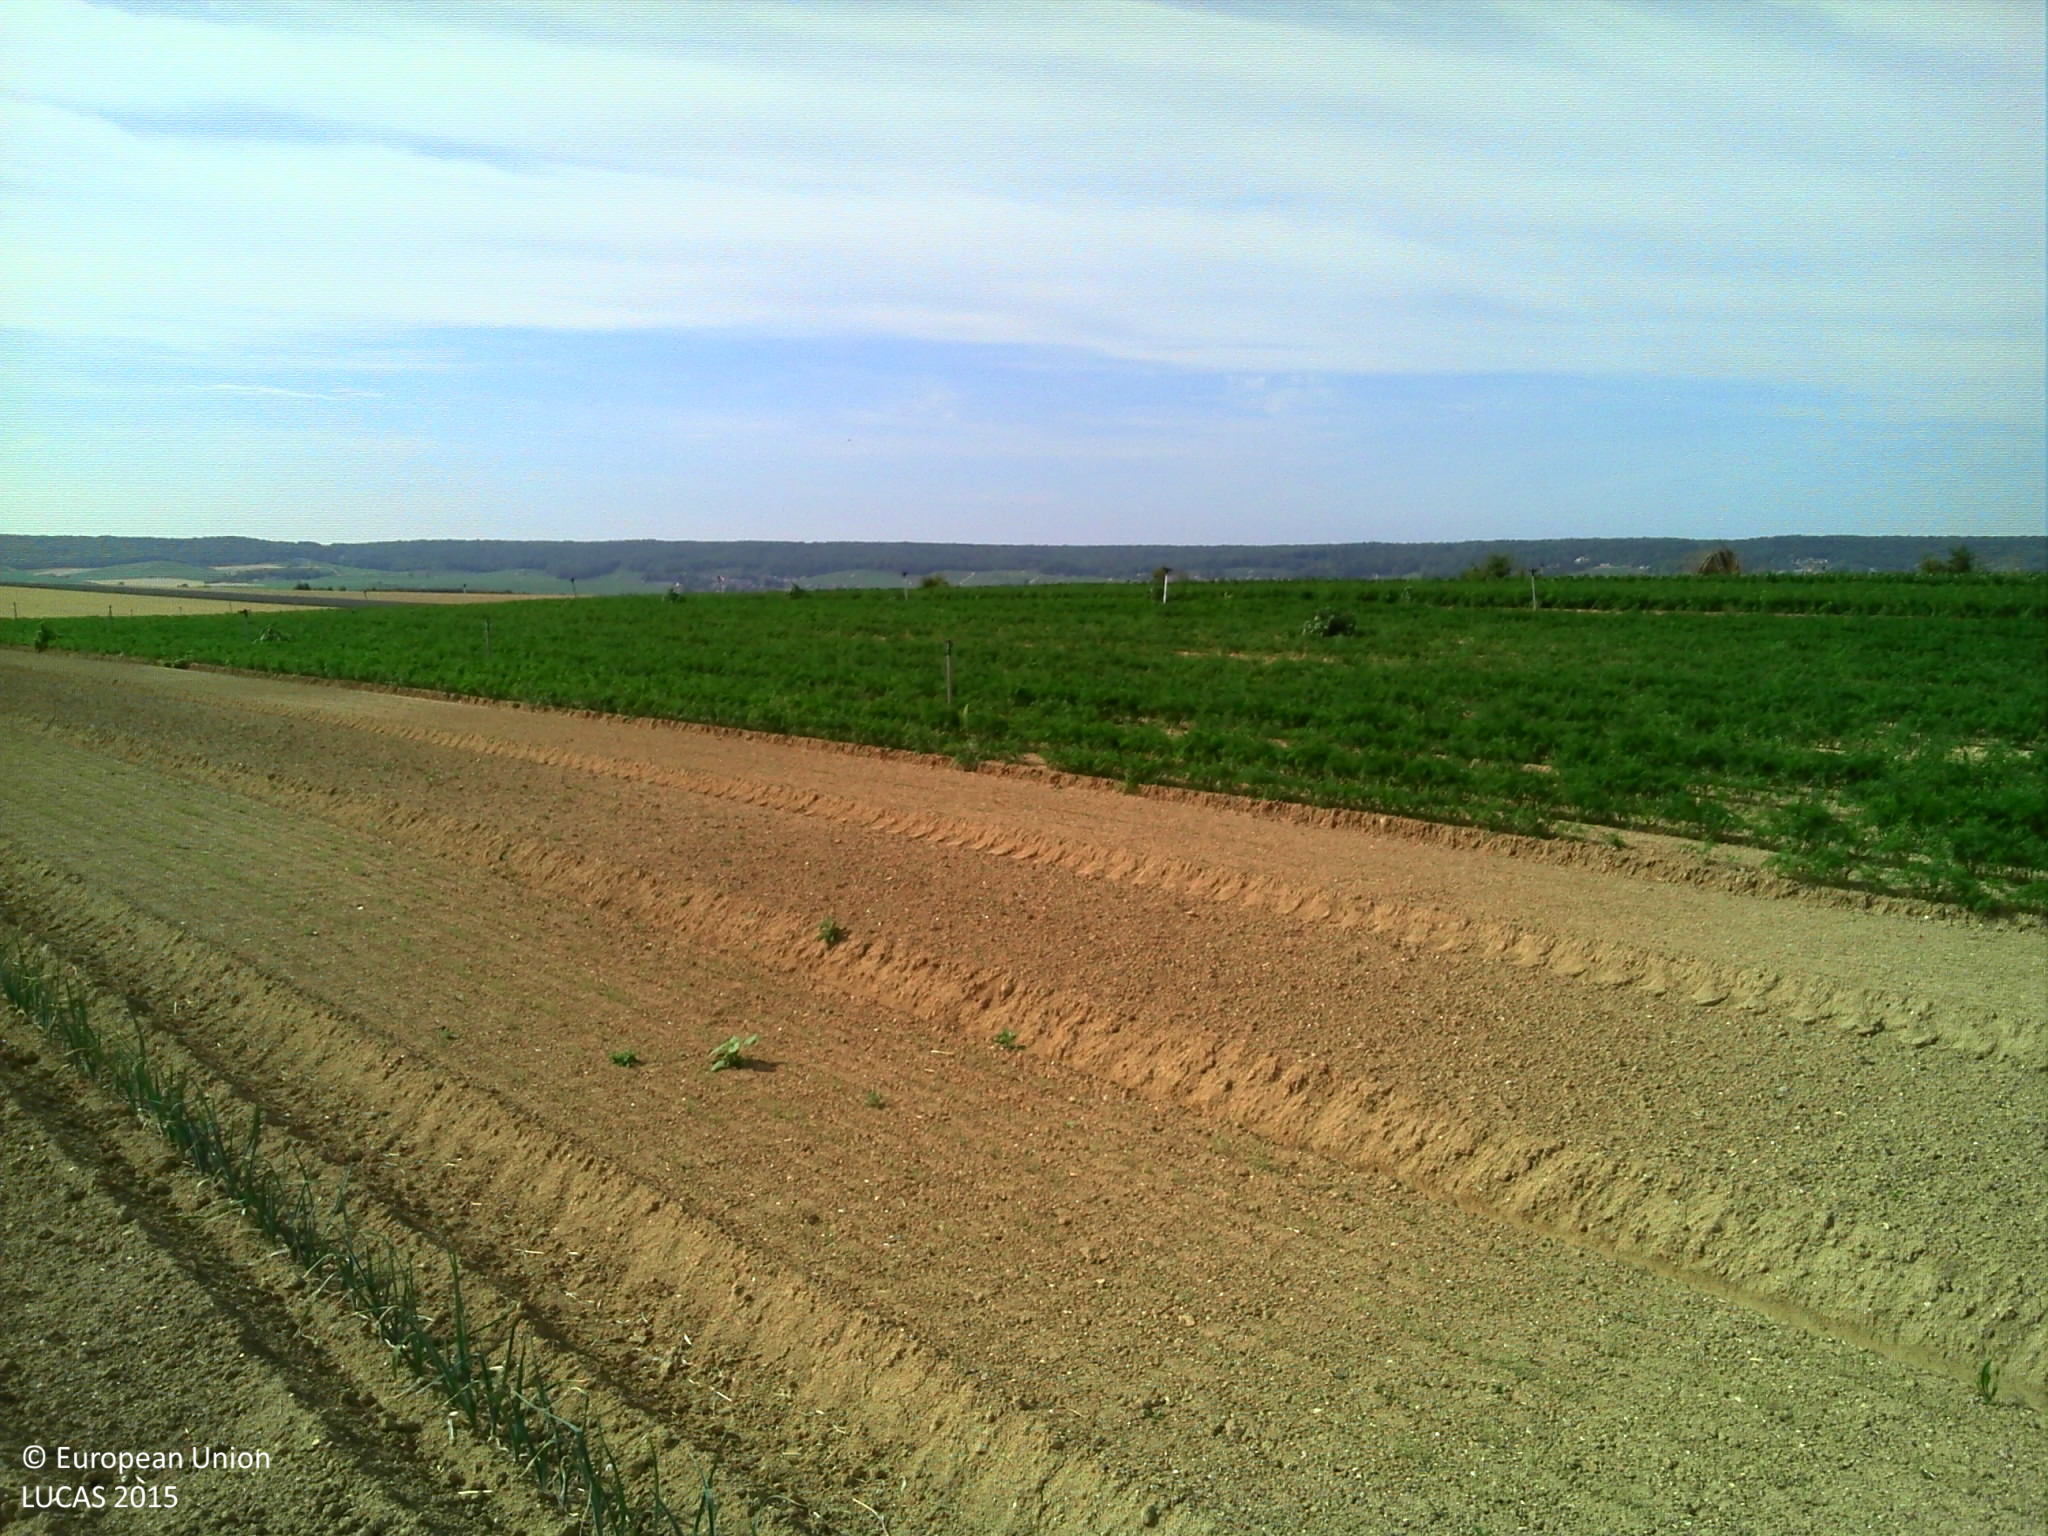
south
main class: Cropland
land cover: Other fresh vegetables
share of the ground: > 75 %
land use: Agriculture (excluding fallow land and kitchen gardens)
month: August
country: FR
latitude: 49.2009
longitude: 4.0800
